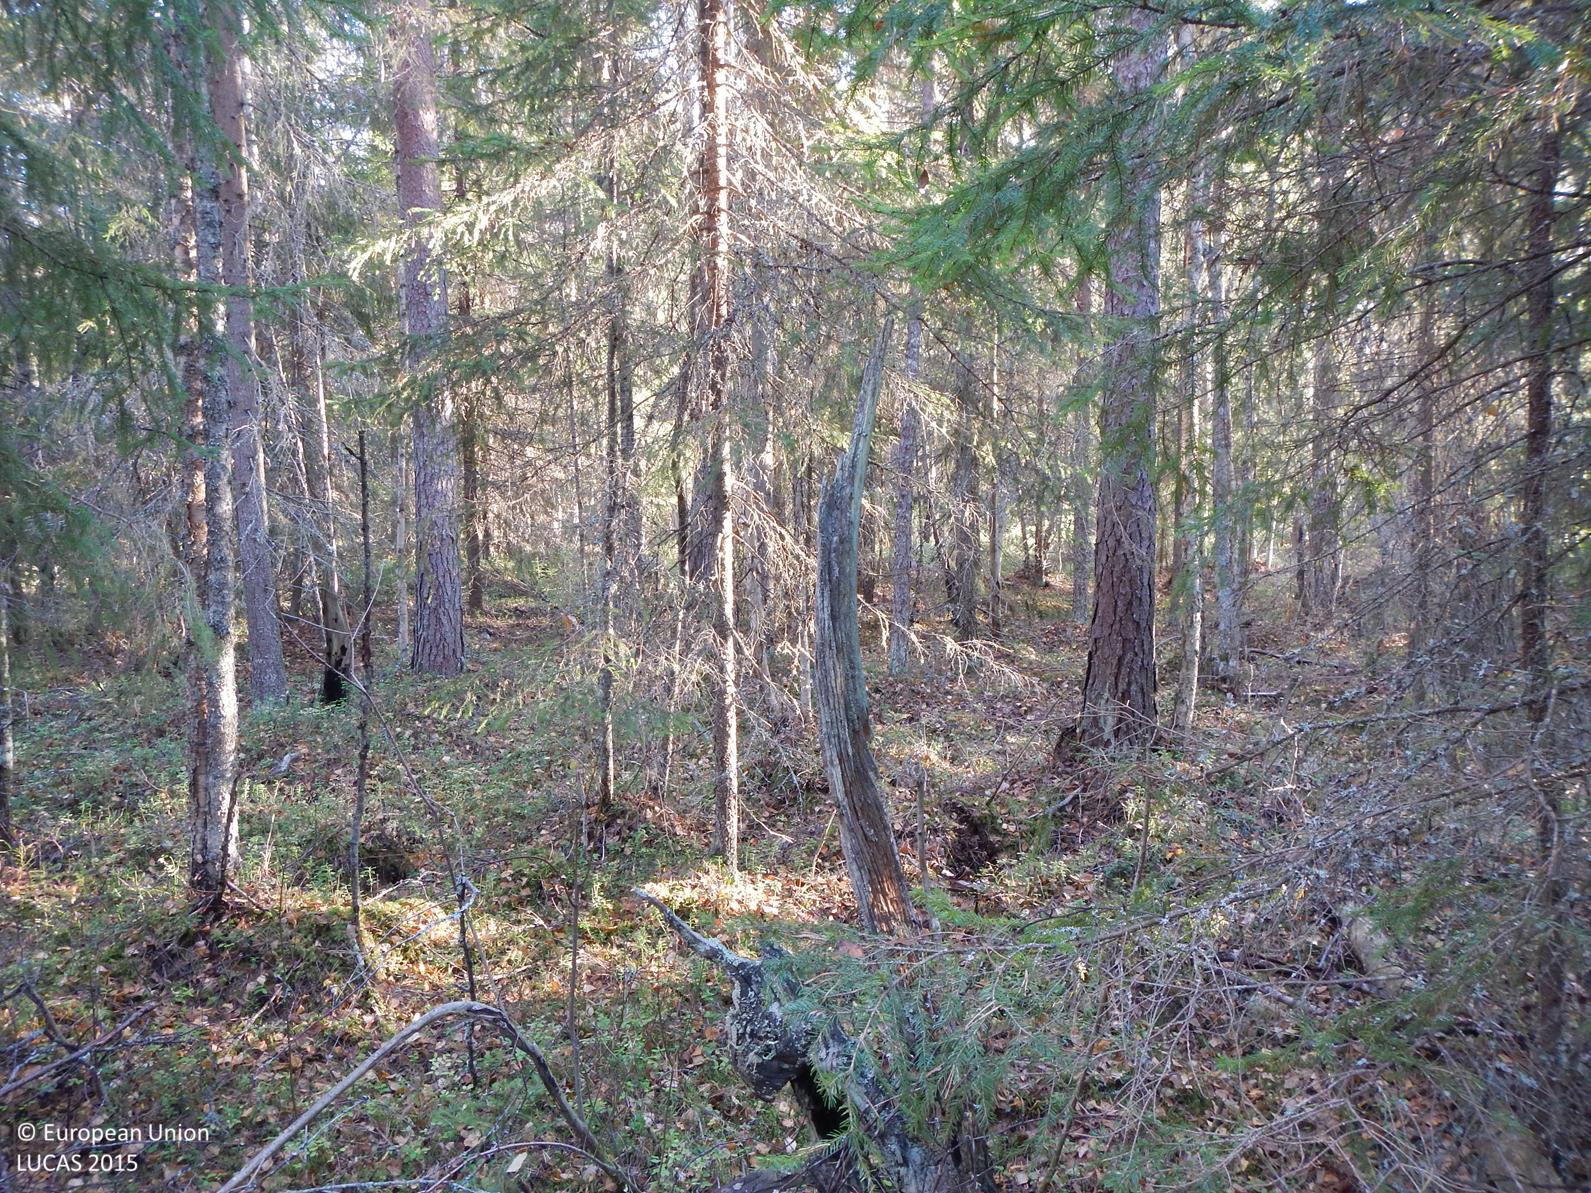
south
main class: Woodland
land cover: Other mixed woodland
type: boreal forest
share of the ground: > 75 %
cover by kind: coniferous forest trees 60 %, broadleaved forest trees 25 %, shrubs 5 %, lichens and mosses 5 %, unconsolidated bare surface 5 %
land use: Forestry
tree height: > 5 m
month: October
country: FI
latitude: 61.9194
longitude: 25.9538
